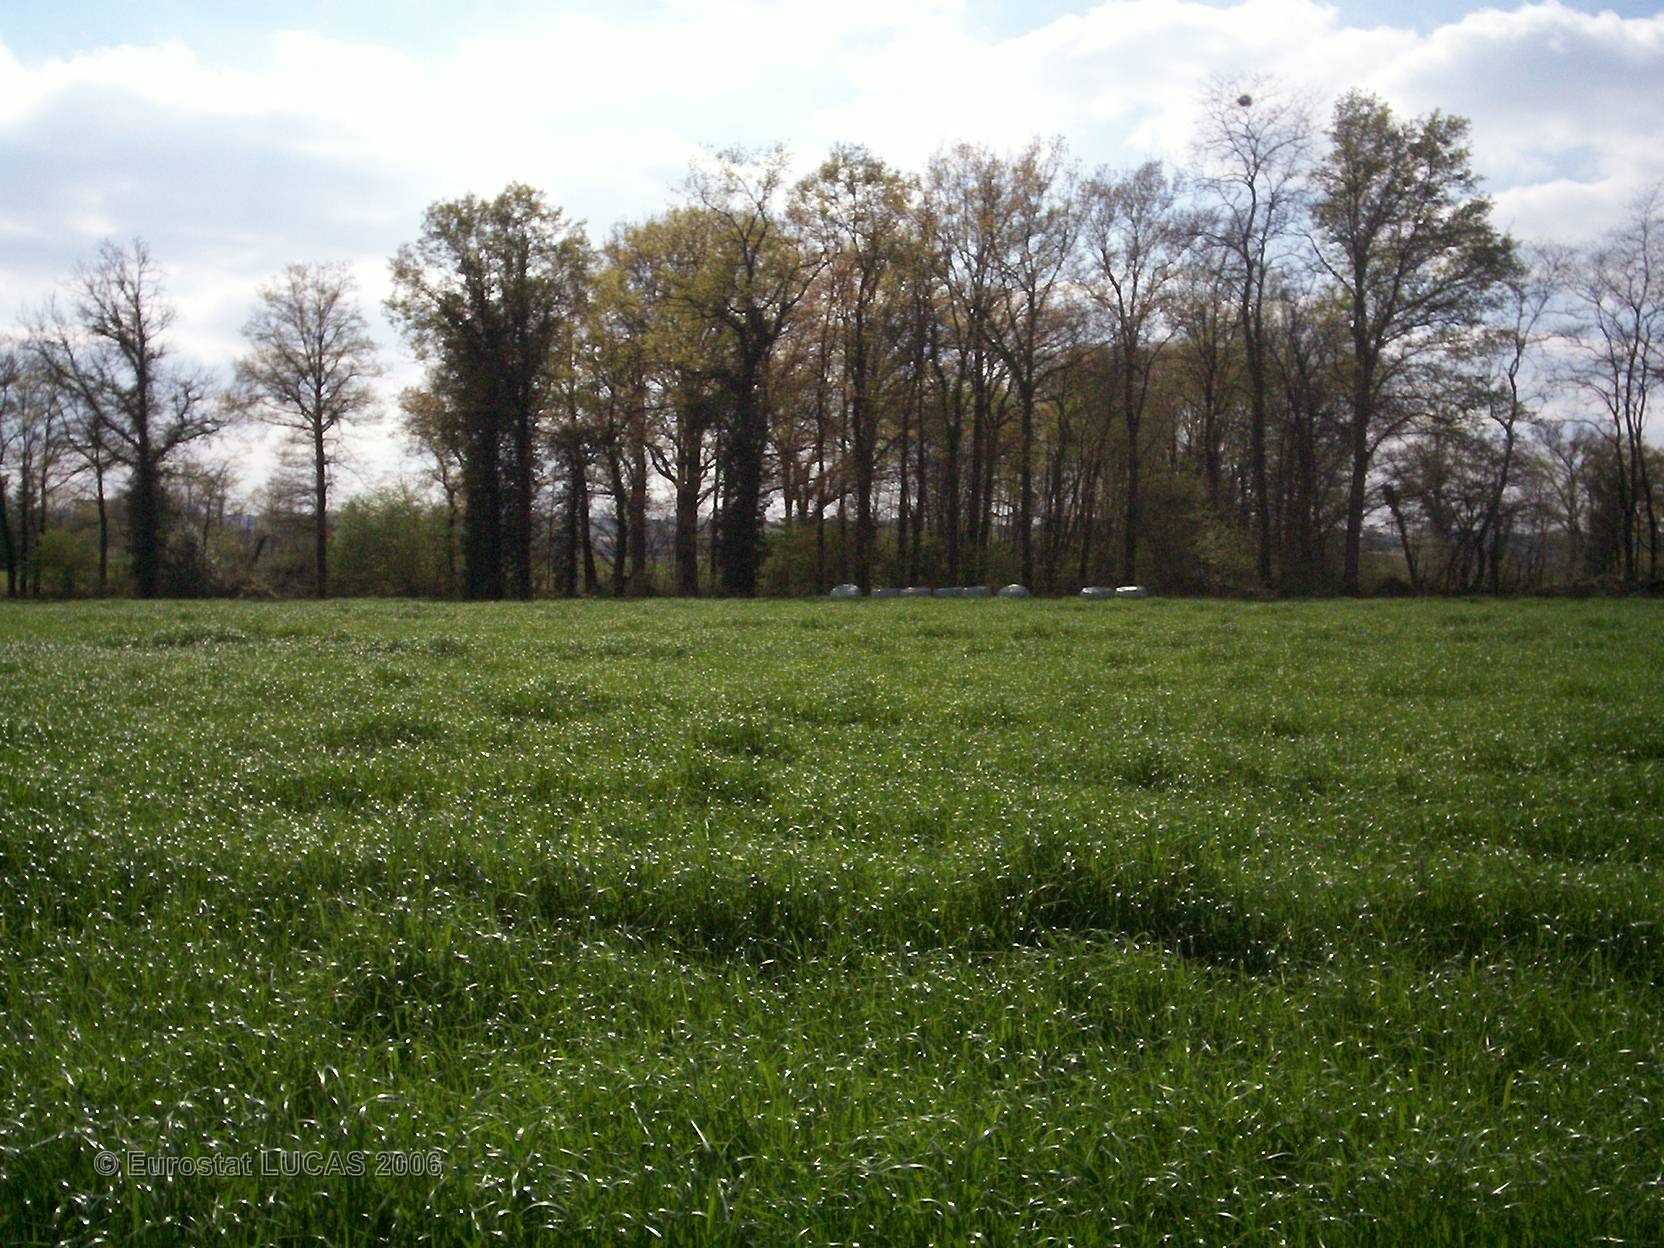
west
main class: Cropland
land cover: Other leguminous and mixtures for fodder
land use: Agriculture (excluding fallow land and kitchen gardens)
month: April
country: FR
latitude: 43.4345
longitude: -0.3230
